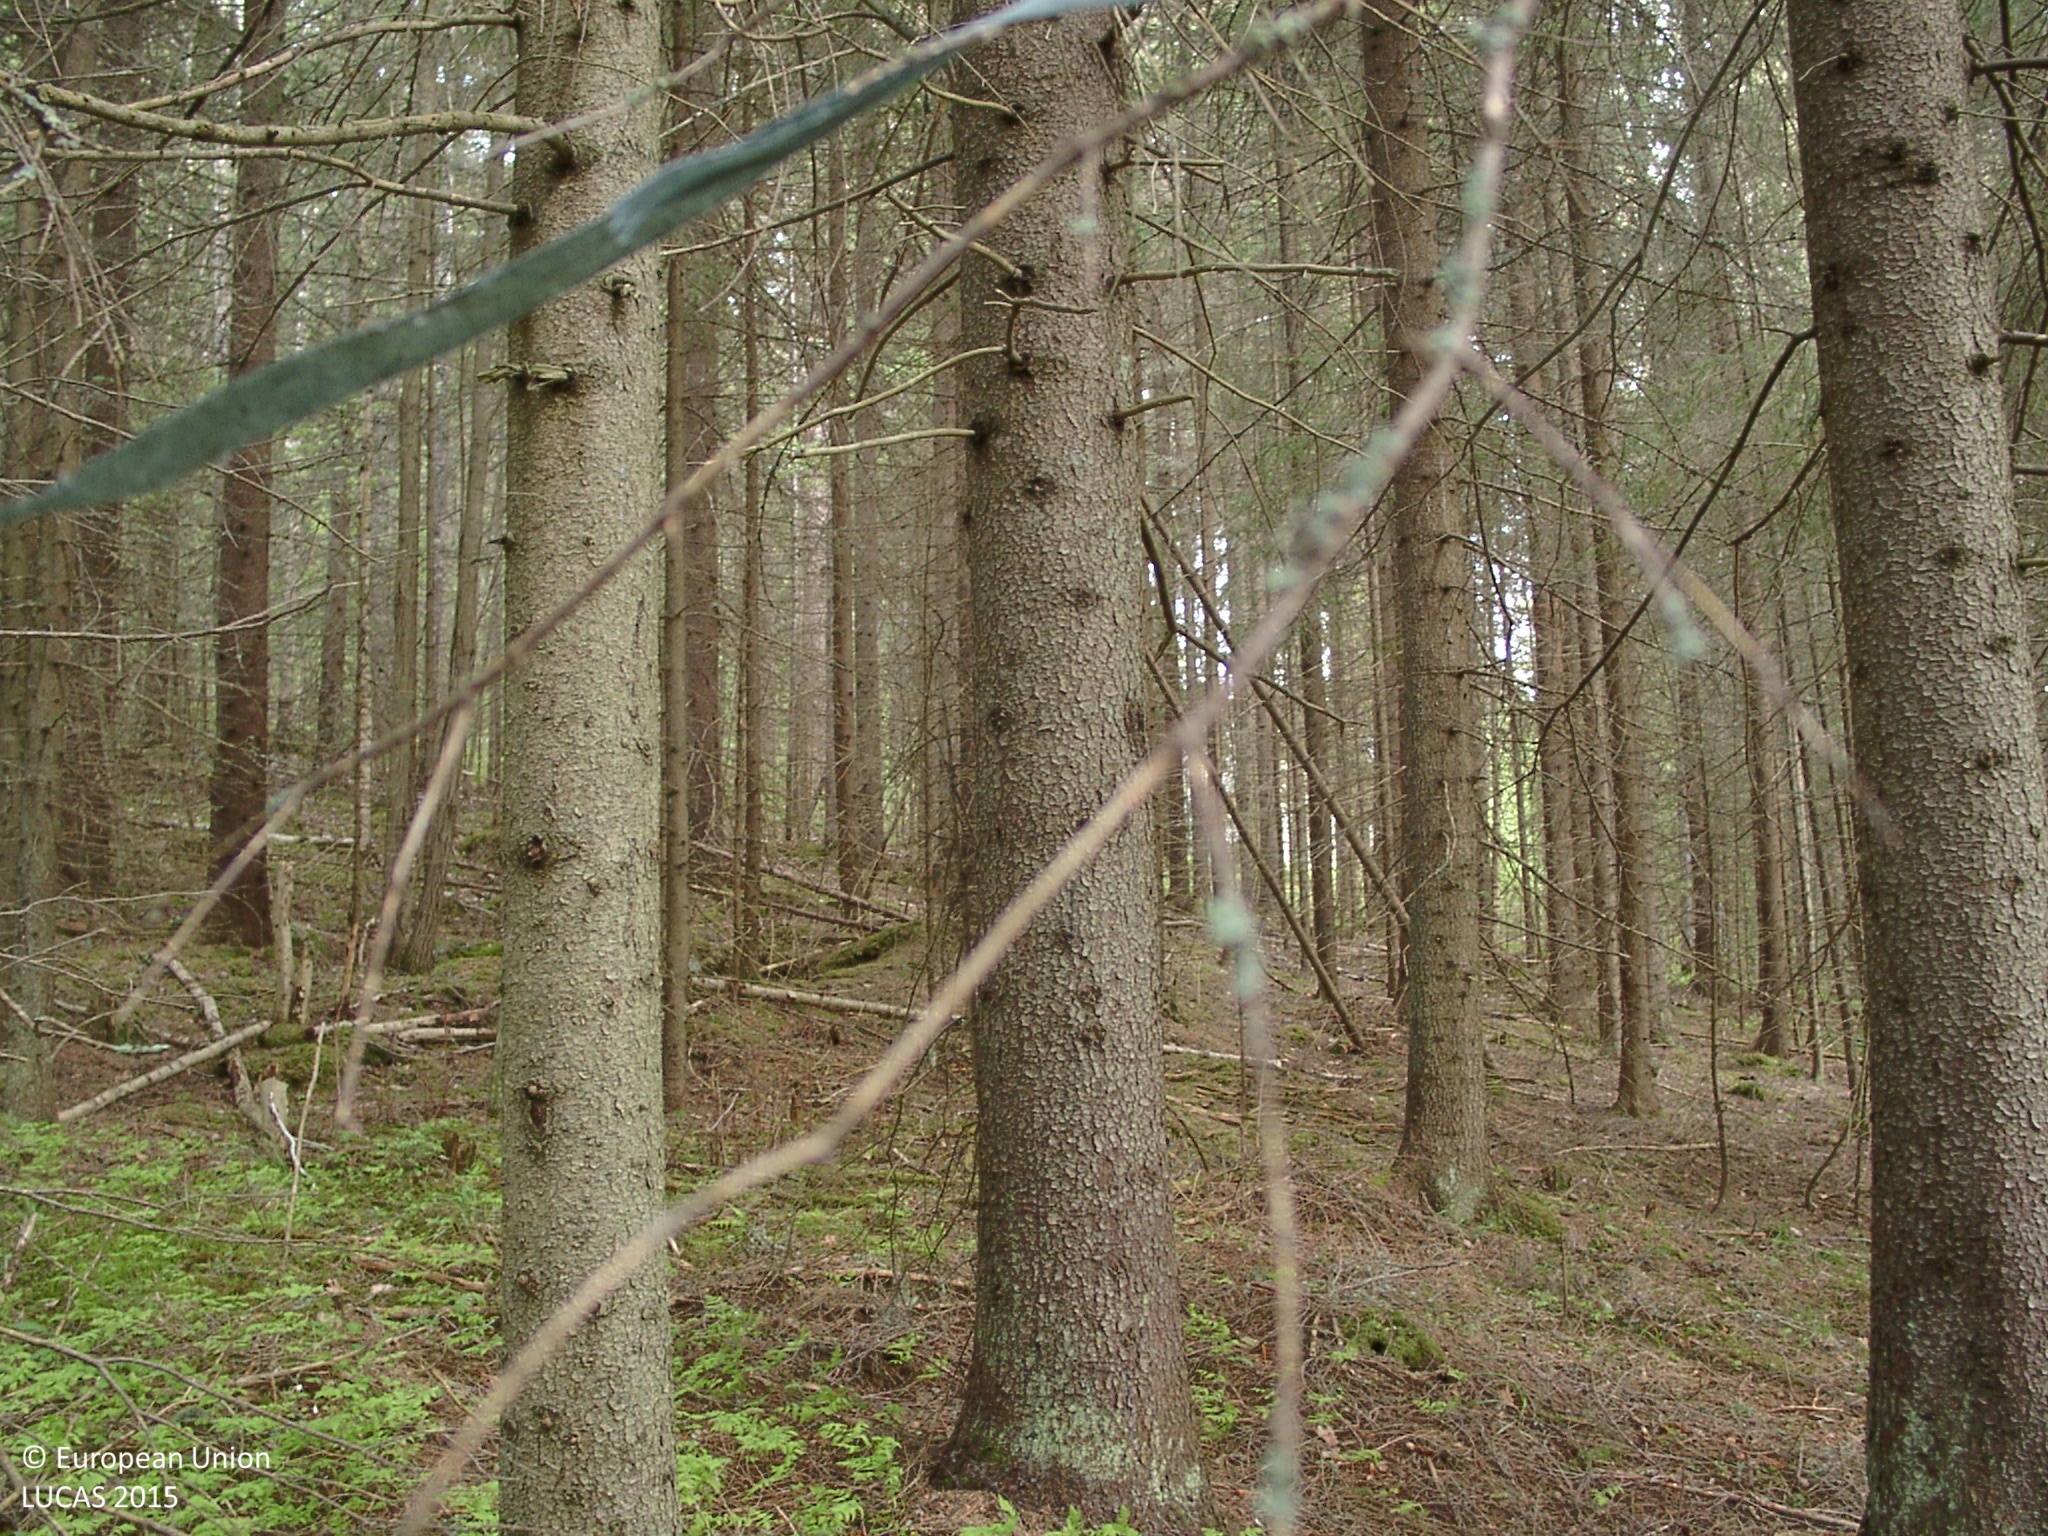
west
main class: Woodland
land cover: Spruce dominated coniferous woodland
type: boreal forest
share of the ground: > 75 %
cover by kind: coniferous forest trees 80 %, herbaceous plants 10 %, broadleaved forest trees 5 %, lichens and mosses 5 %
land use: Forestry
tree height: > 5 m
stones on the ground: < 10 %
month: June
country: FI
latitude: 62.1677
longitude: 25.5329
